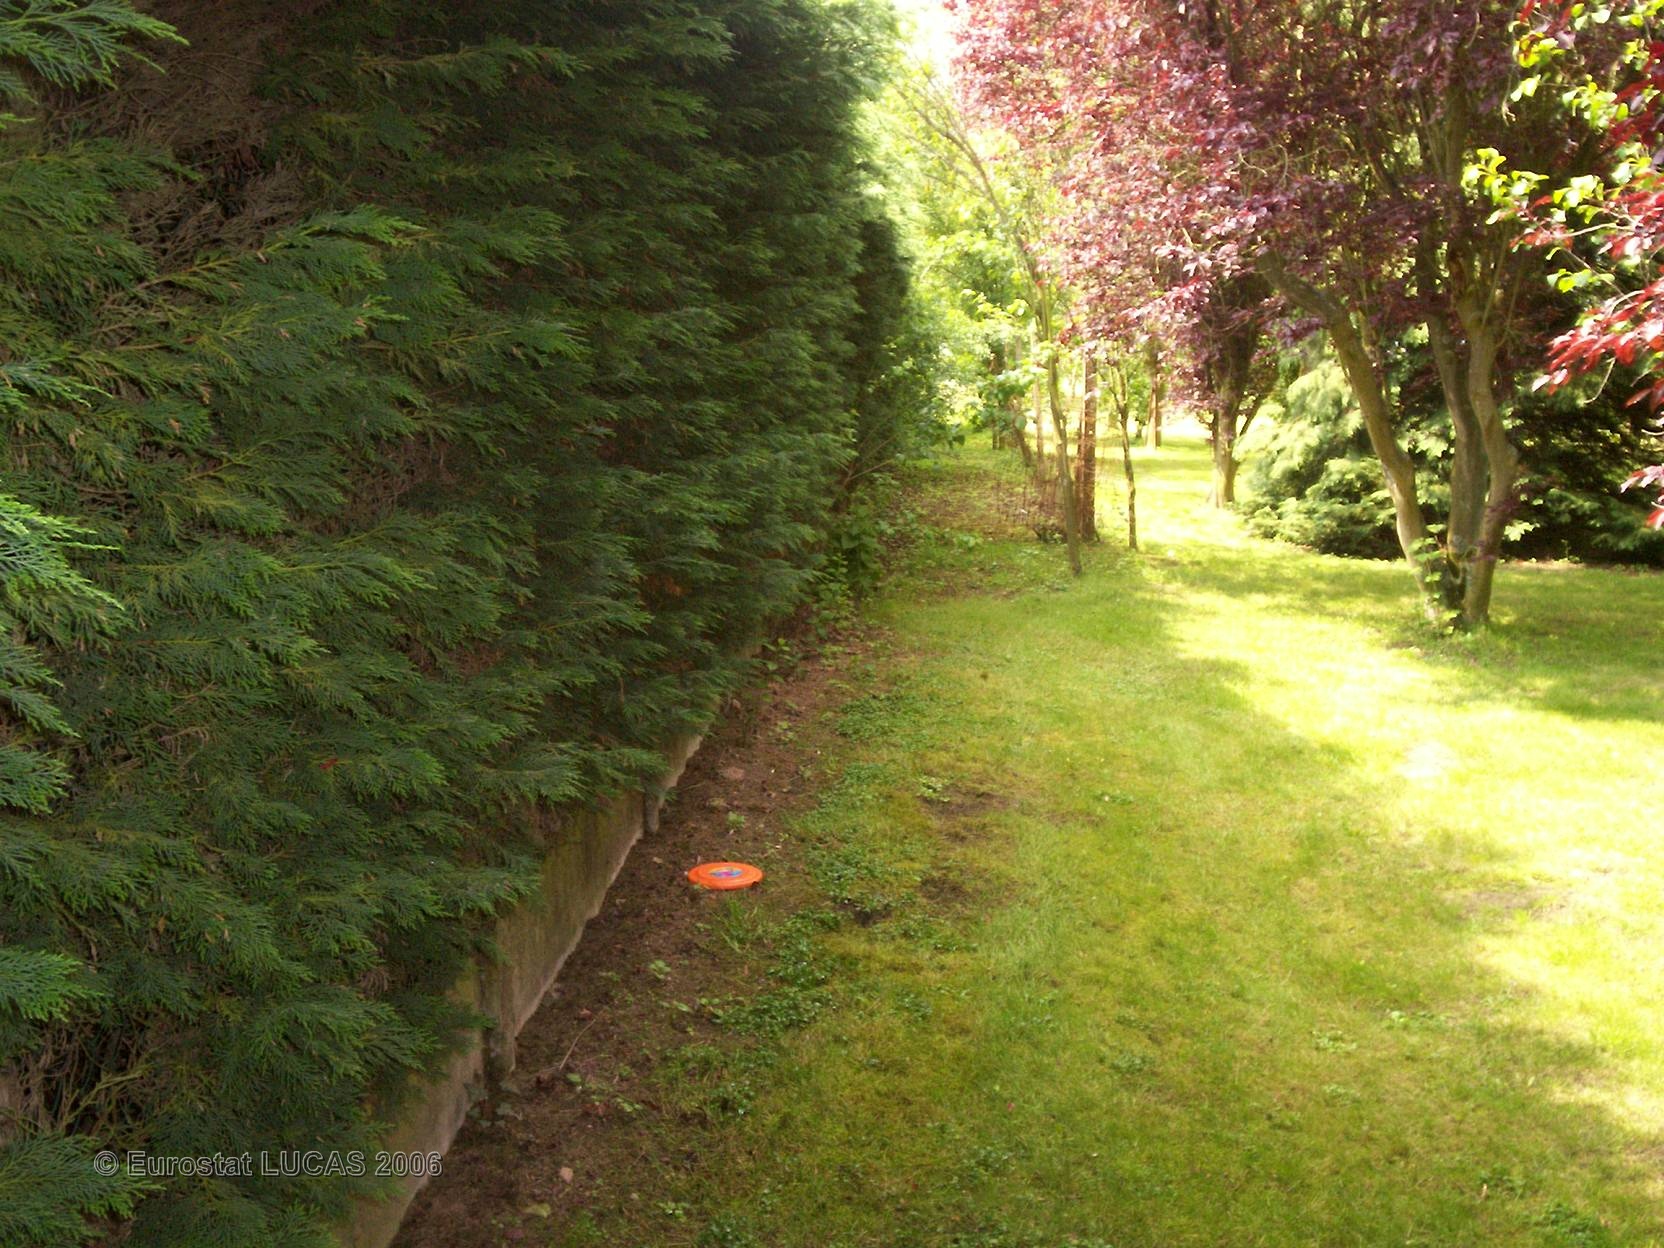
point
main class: Grassland
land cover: Grassland with sparse tree/shrub cover
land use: Residential
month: June
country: FR
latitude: 49.7498
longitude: 2.6745
